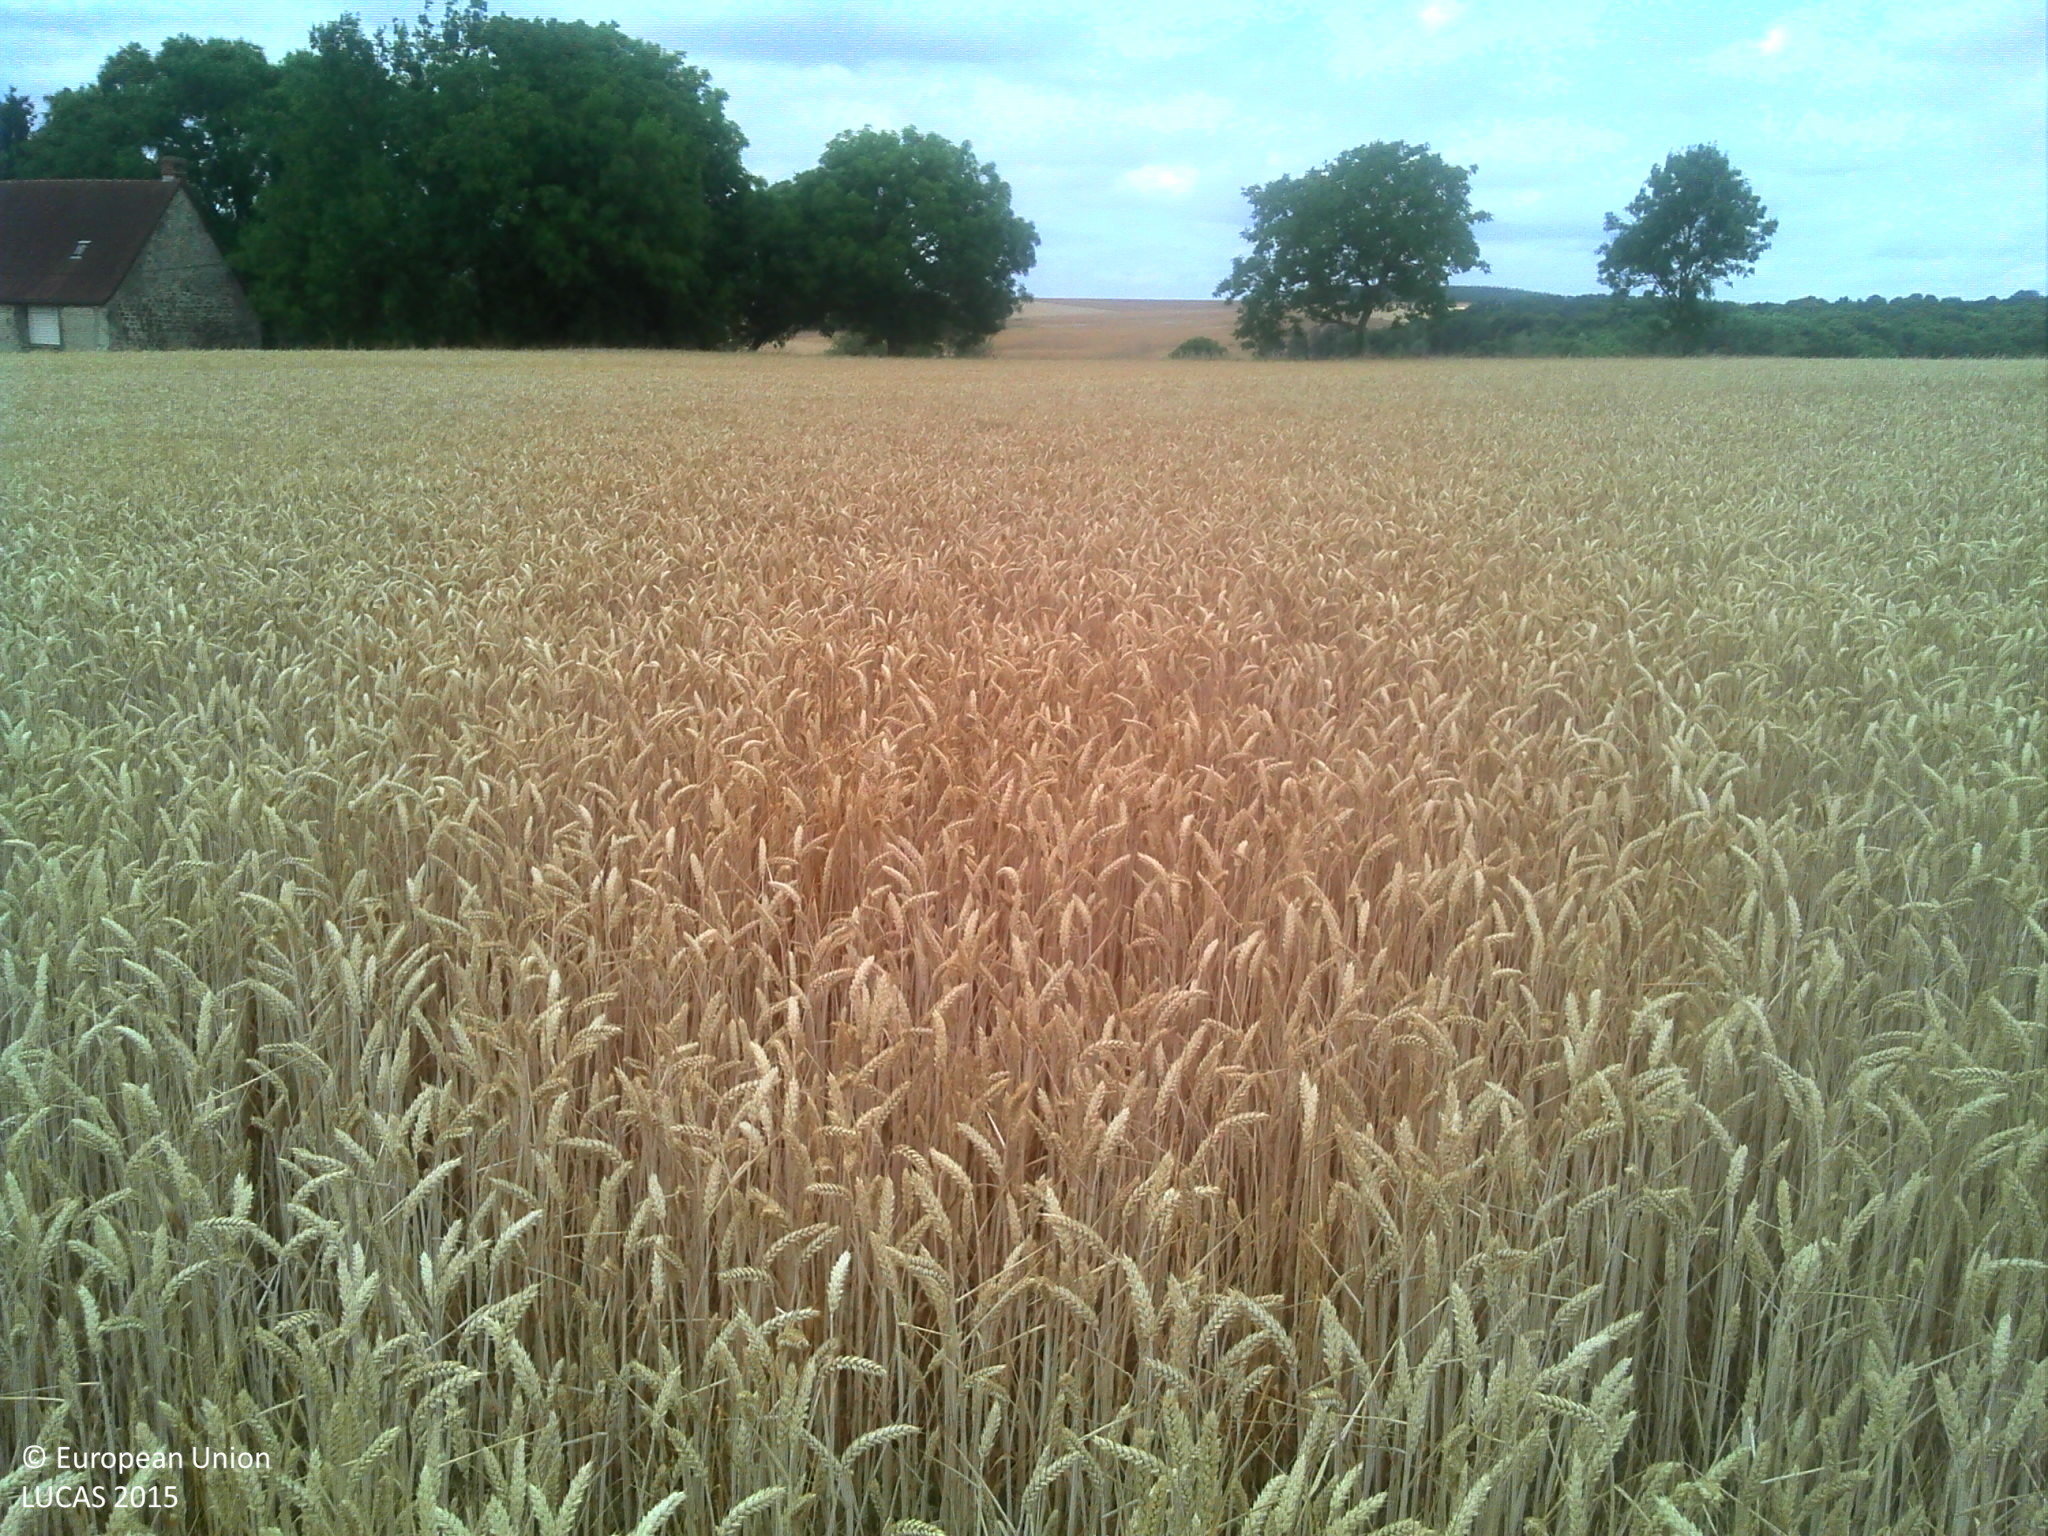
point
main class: Cropland
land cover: Common wheat
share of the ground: > 75 %
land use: Agriculture (excluding fallow land and kitchen gardens)
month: July
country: FR
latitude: 49.2311
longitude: 3.3320
